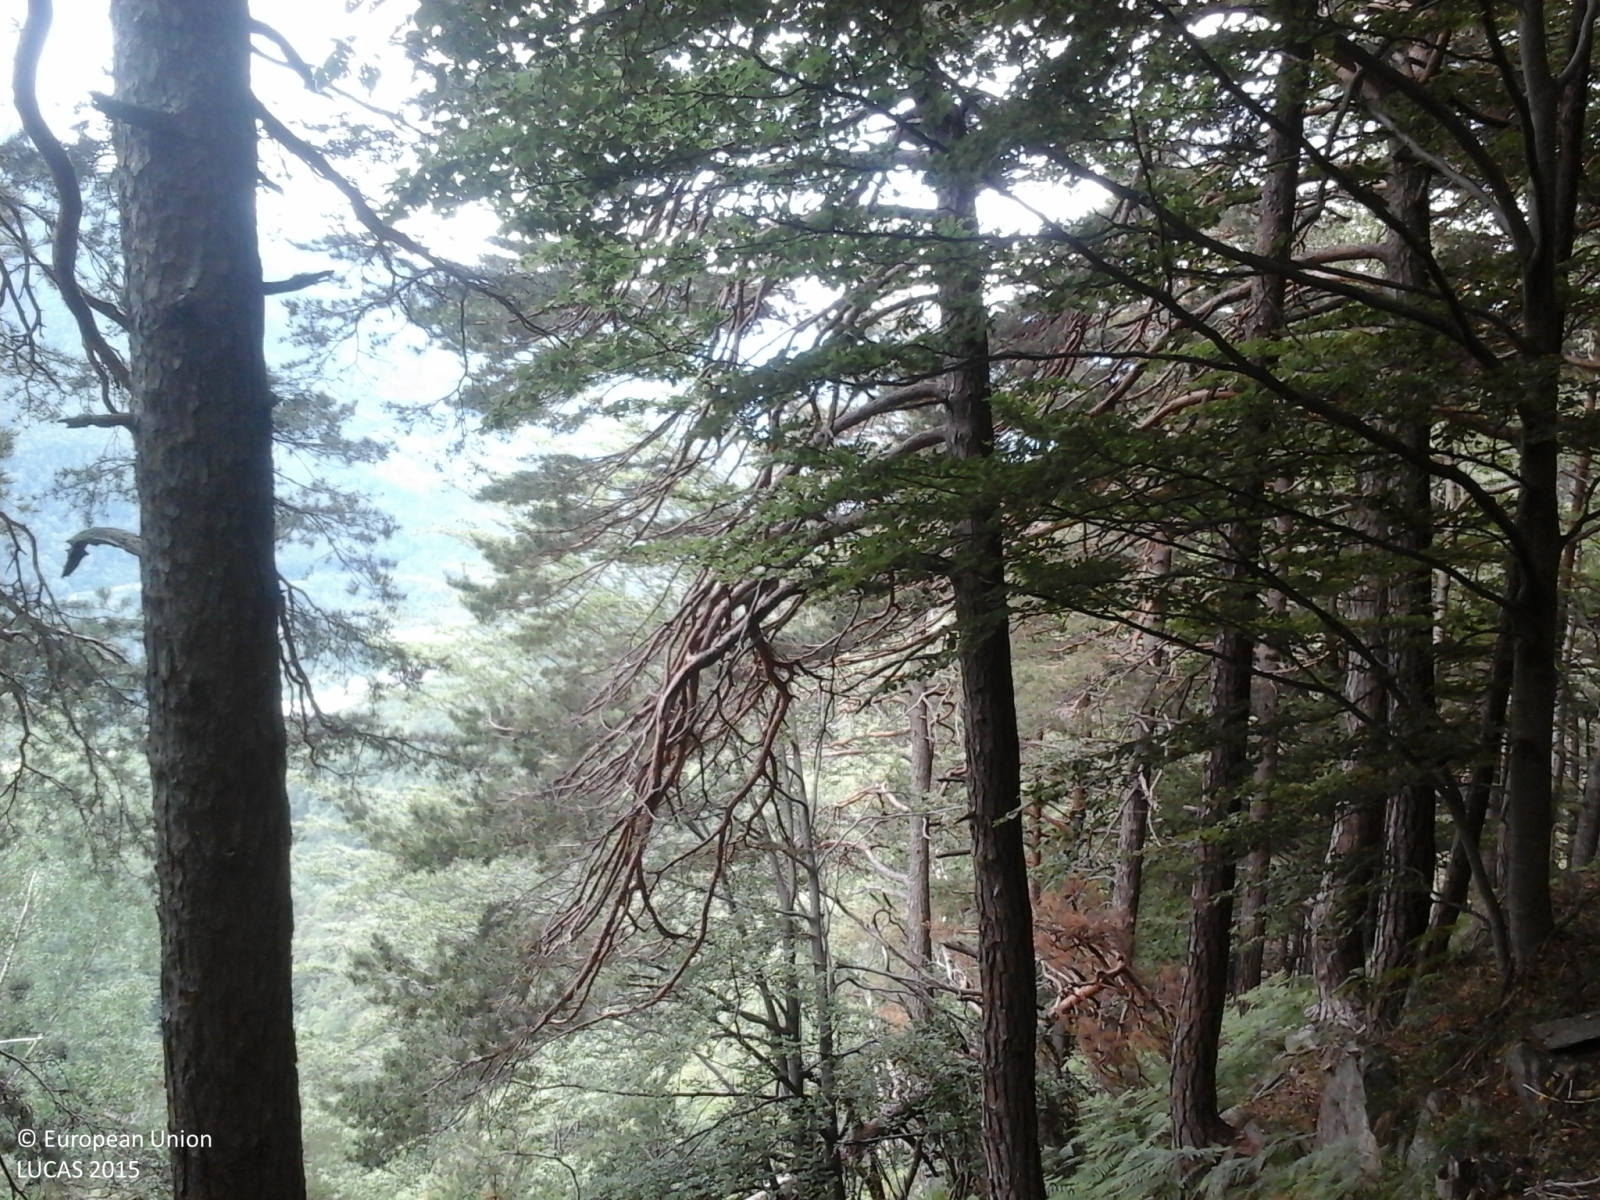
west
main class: Woodland
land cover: Other mixed woodland
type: mountainous beech forest
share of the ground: > 75 %
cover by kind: broadleaved forest trees 75 %, coniferous forest trees 25 %
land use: Forestry
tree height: > 5 m
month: June
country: IT
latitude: 46.1412
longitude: 8.4099
